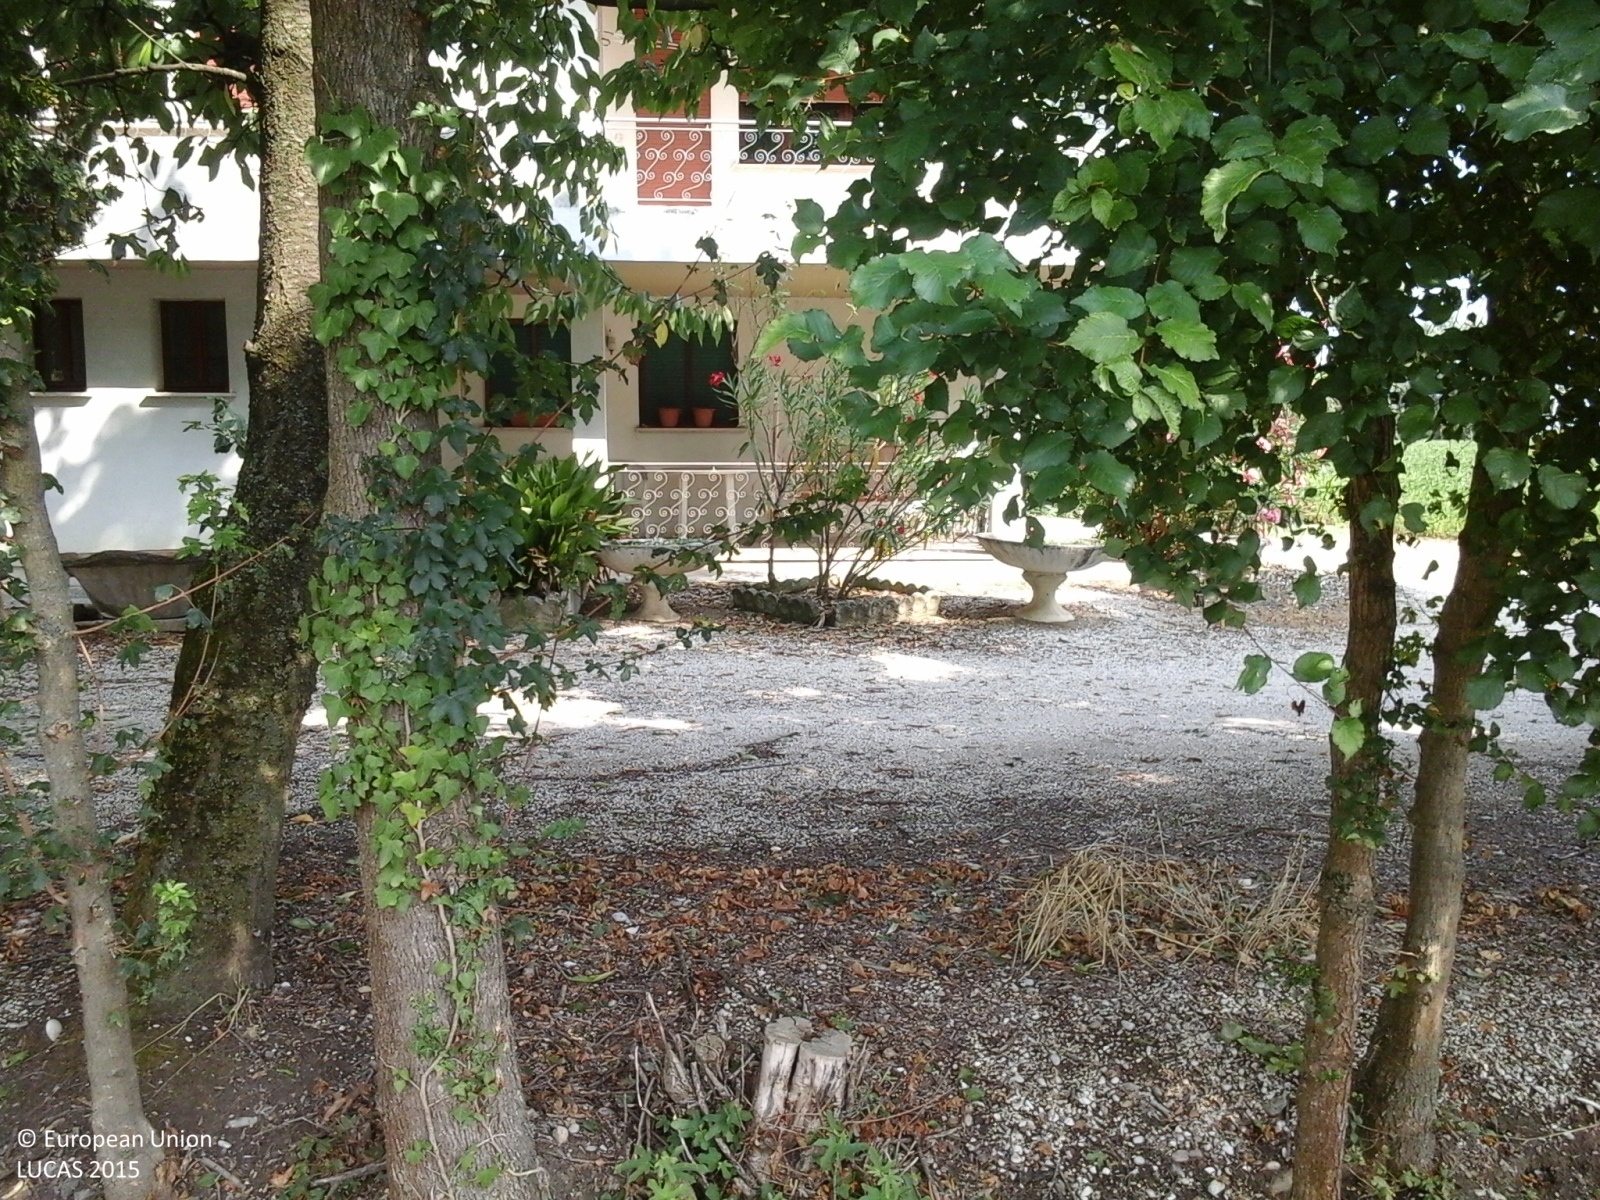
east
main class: Cropland
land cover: Maize
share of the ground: > 75 %
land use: Agriculture (excluding fallow land and kitchen gardens)
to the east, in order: Maize; Ditches and canals; Soya; Grass margins; Ditches and canals; Lines of trees; Artificial constructions in urban areas; Broadleaved woodland; Grass margins; Soya; Electric lines; Soya
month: June
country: IT
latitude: 45.7620
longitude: 12.5551
